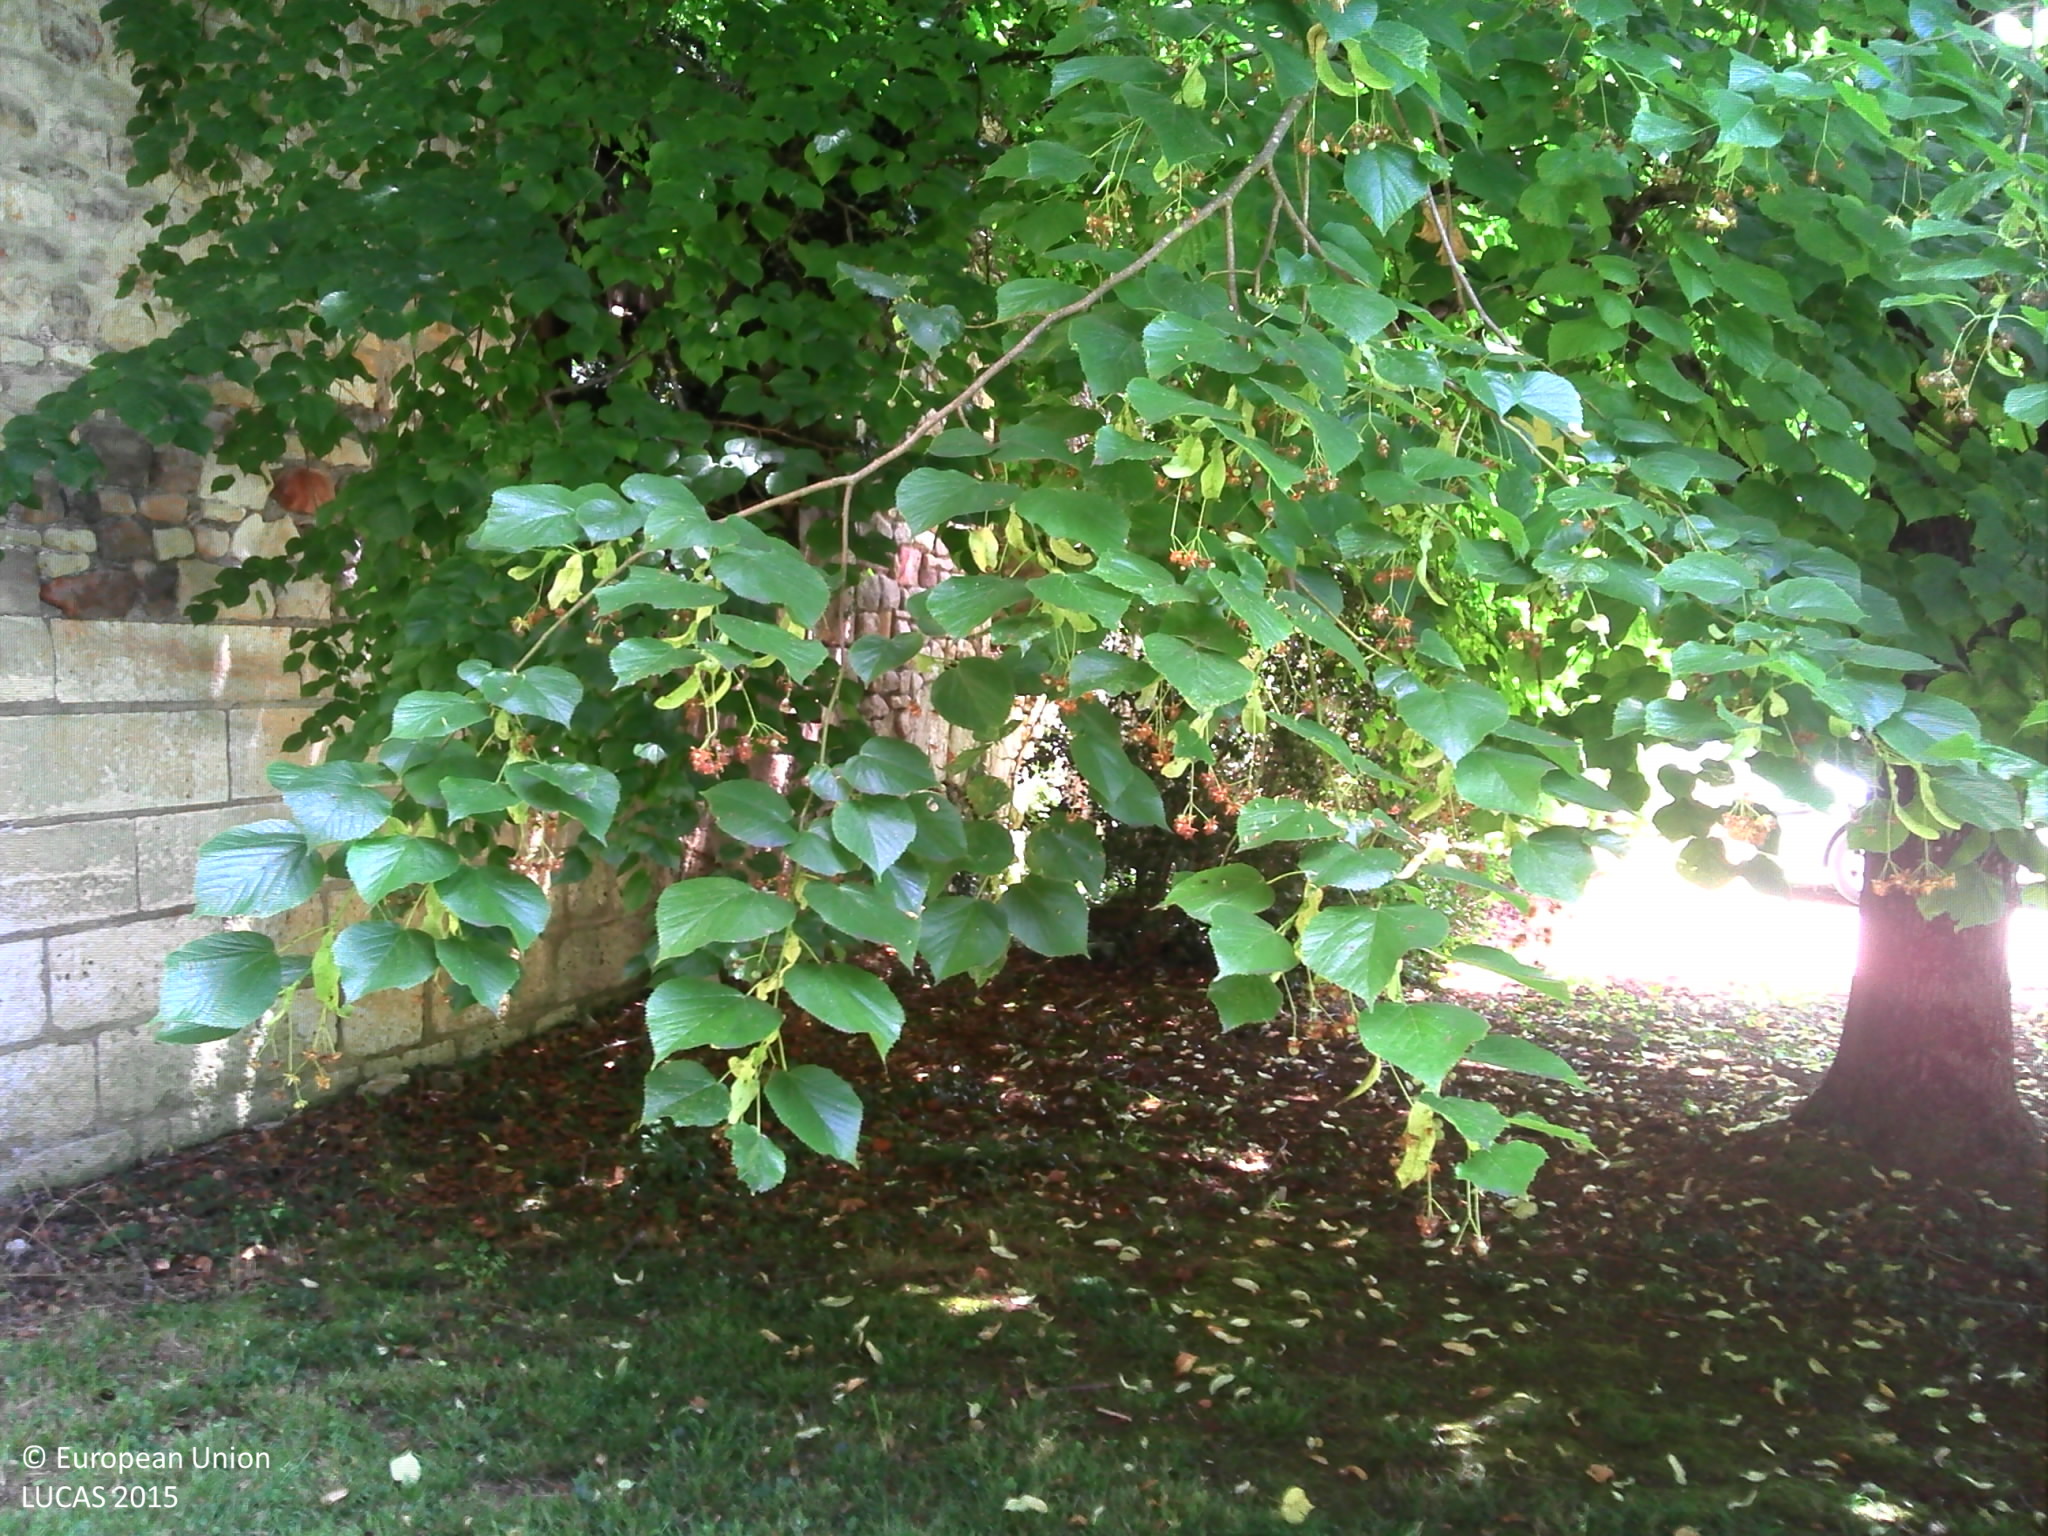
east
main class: Grassland
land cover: Grassland with sparse tree/shrub cover
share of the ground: > 75 %
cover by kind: herbaceous plants 95 %, broadleaved forest trees 5 %
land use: Amenities, museums, leisure
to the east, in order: Grassland with sparse tree/shrub cover; Artificial constructions in urban areas; Broadleaved woodland; Artificial constructions in urban areas; Broadleaved woodland; Maize
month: June
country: FR
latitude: 45.7738
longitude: 0.4042
